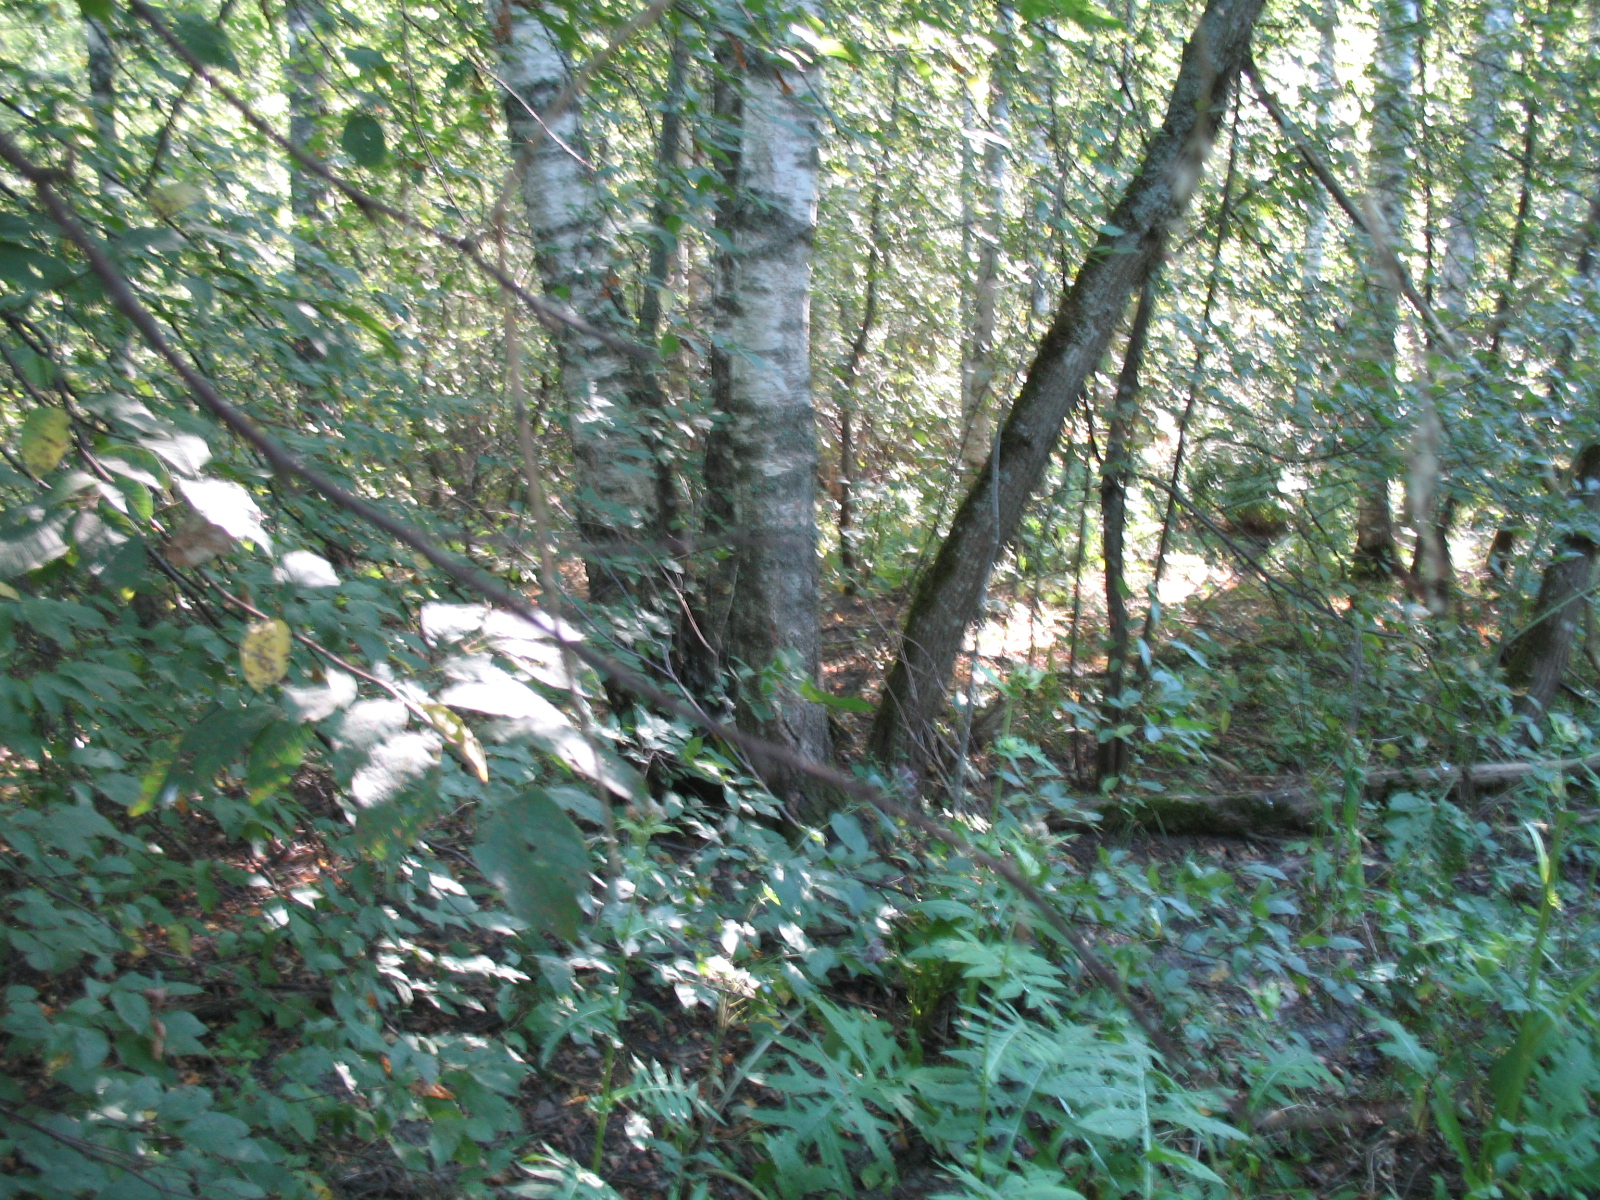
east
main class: Woodland
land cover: Broadleaved woodland
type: non-riverine alder, birch or aspen forest
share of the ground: 50 - 75 %
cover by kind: broadleaved forest trees 65 %, herbaceous plants 25 %, shrubs 10 %
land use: Forestry
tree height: > 5 m
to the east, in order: Broadleaved woodland; Shrubland with sparse tree cover; Electric lines; Spontaneously vegetated surfaces; Ditches and canals; Other mixed woodland; Spruce dominated mixed woodland
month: August
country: LV
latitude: 56.4352
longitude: 25.6112
